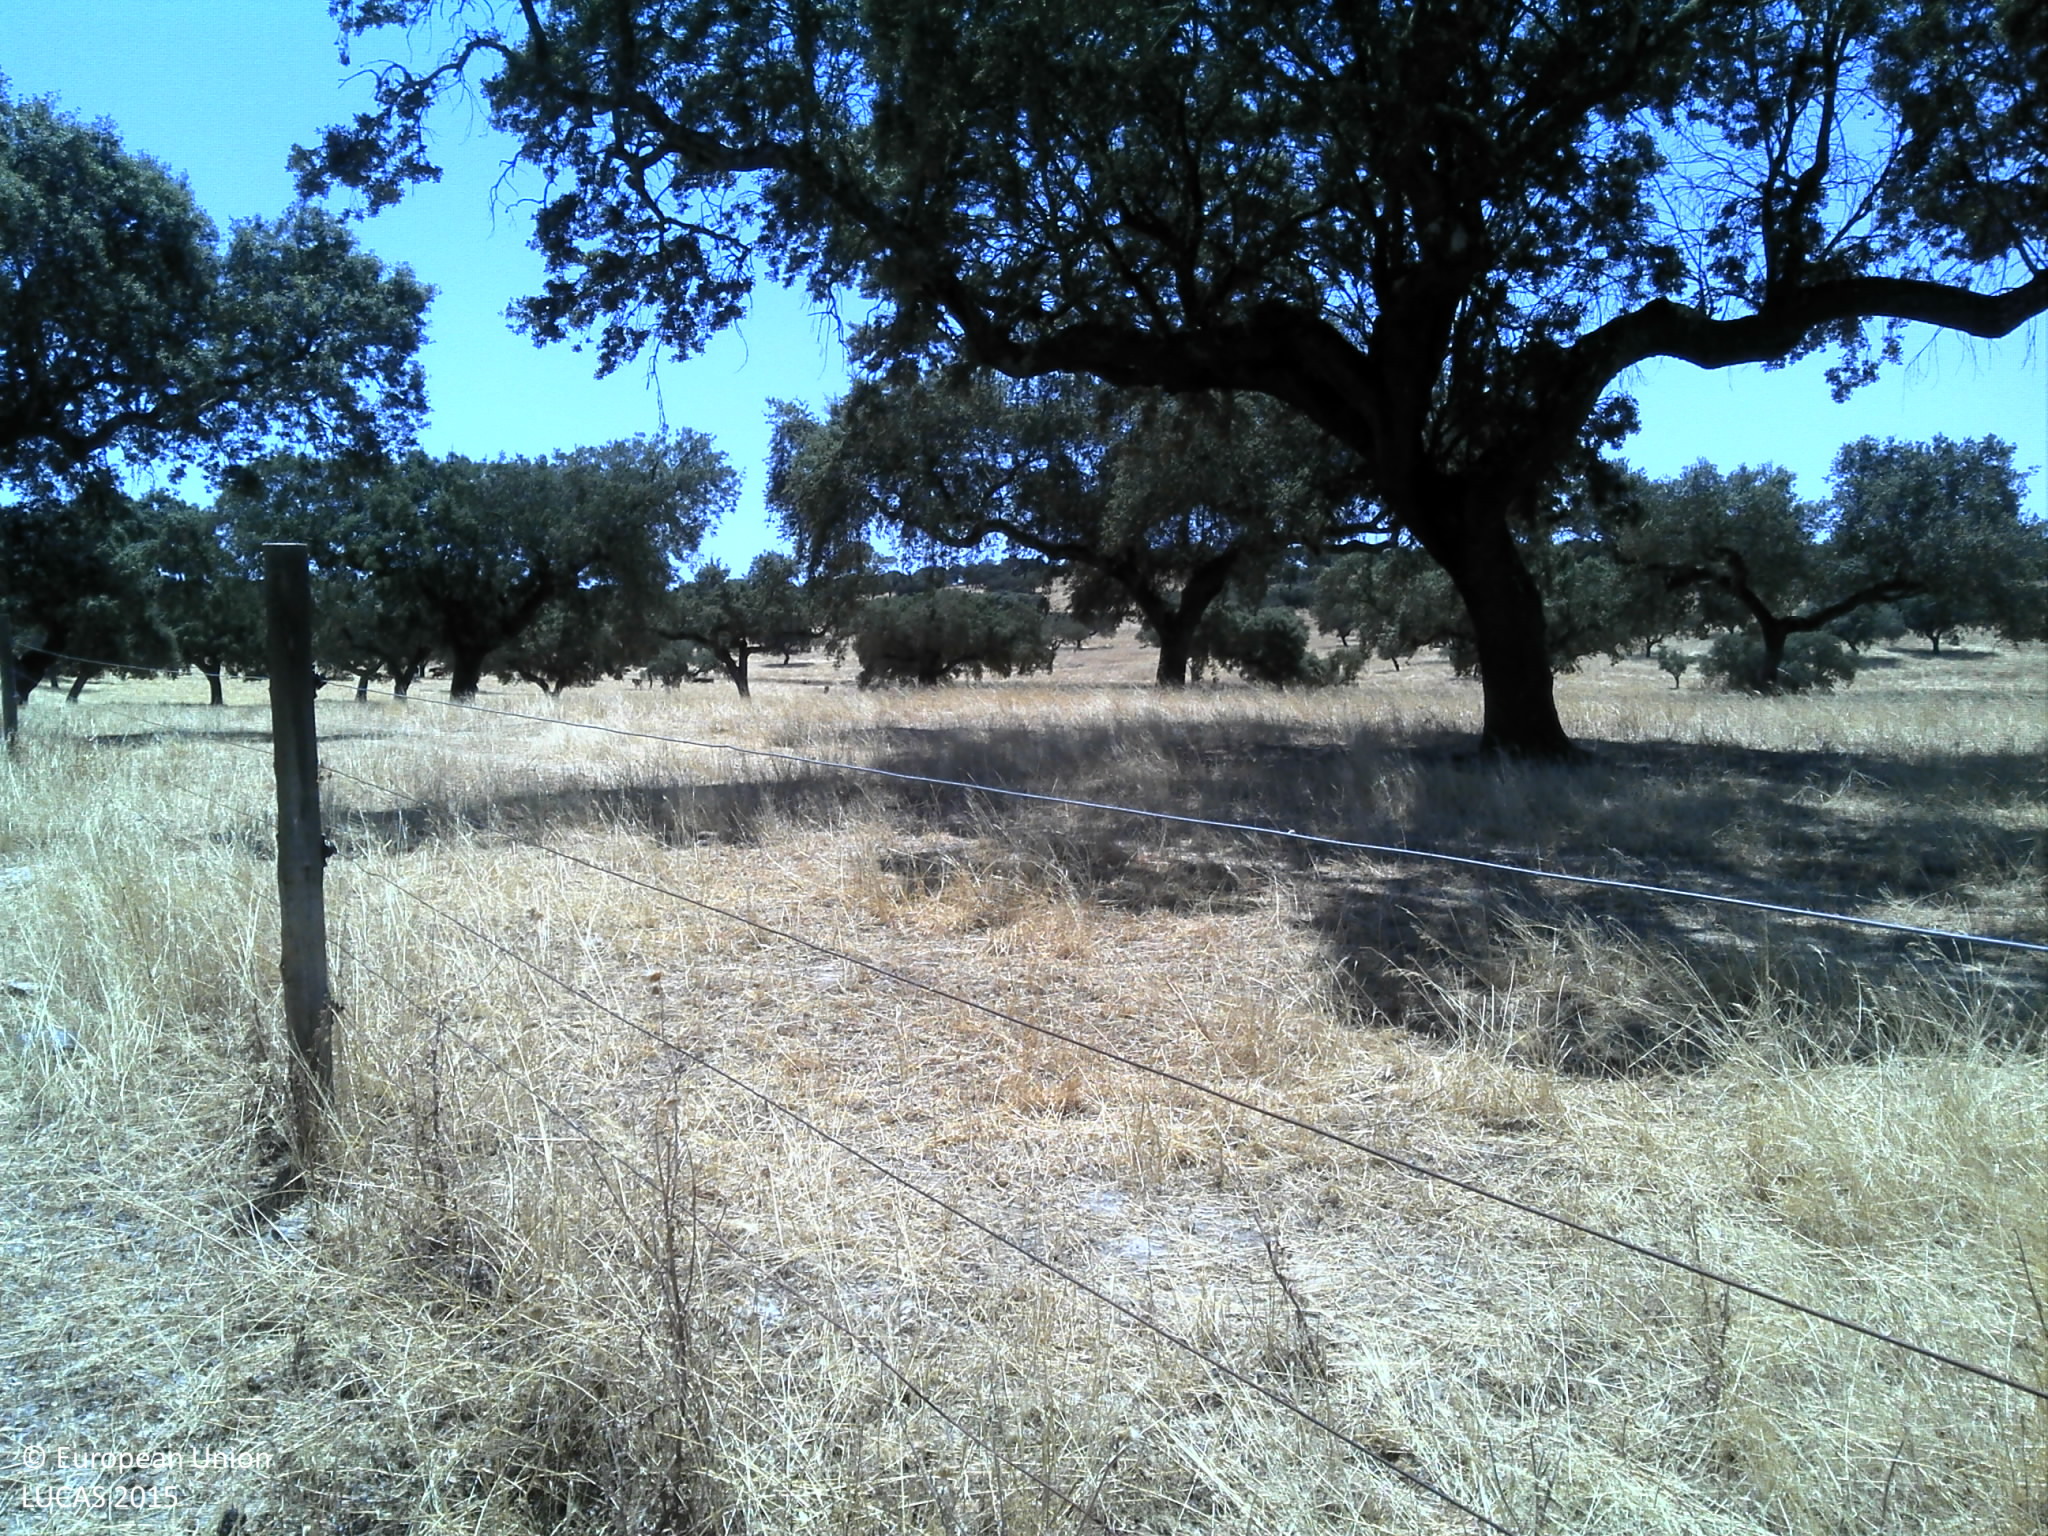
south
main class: Woodland
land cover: Broadleaved woodland
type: broadleaved evergreen forest
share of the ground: 10 - 25 %
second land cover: Grassland without tree/shrub cover
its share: 50 - 75 %
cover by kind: herbaceous plants 60 %, broadleaved forest trees 25 %, unconsolidated bare surface 15 %
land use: Forestry
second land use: Agriculture (excluding fallow land and kitchen gardens)
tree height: > 5 m
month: July
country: PT
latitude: 38.2390
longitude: -7.1889
